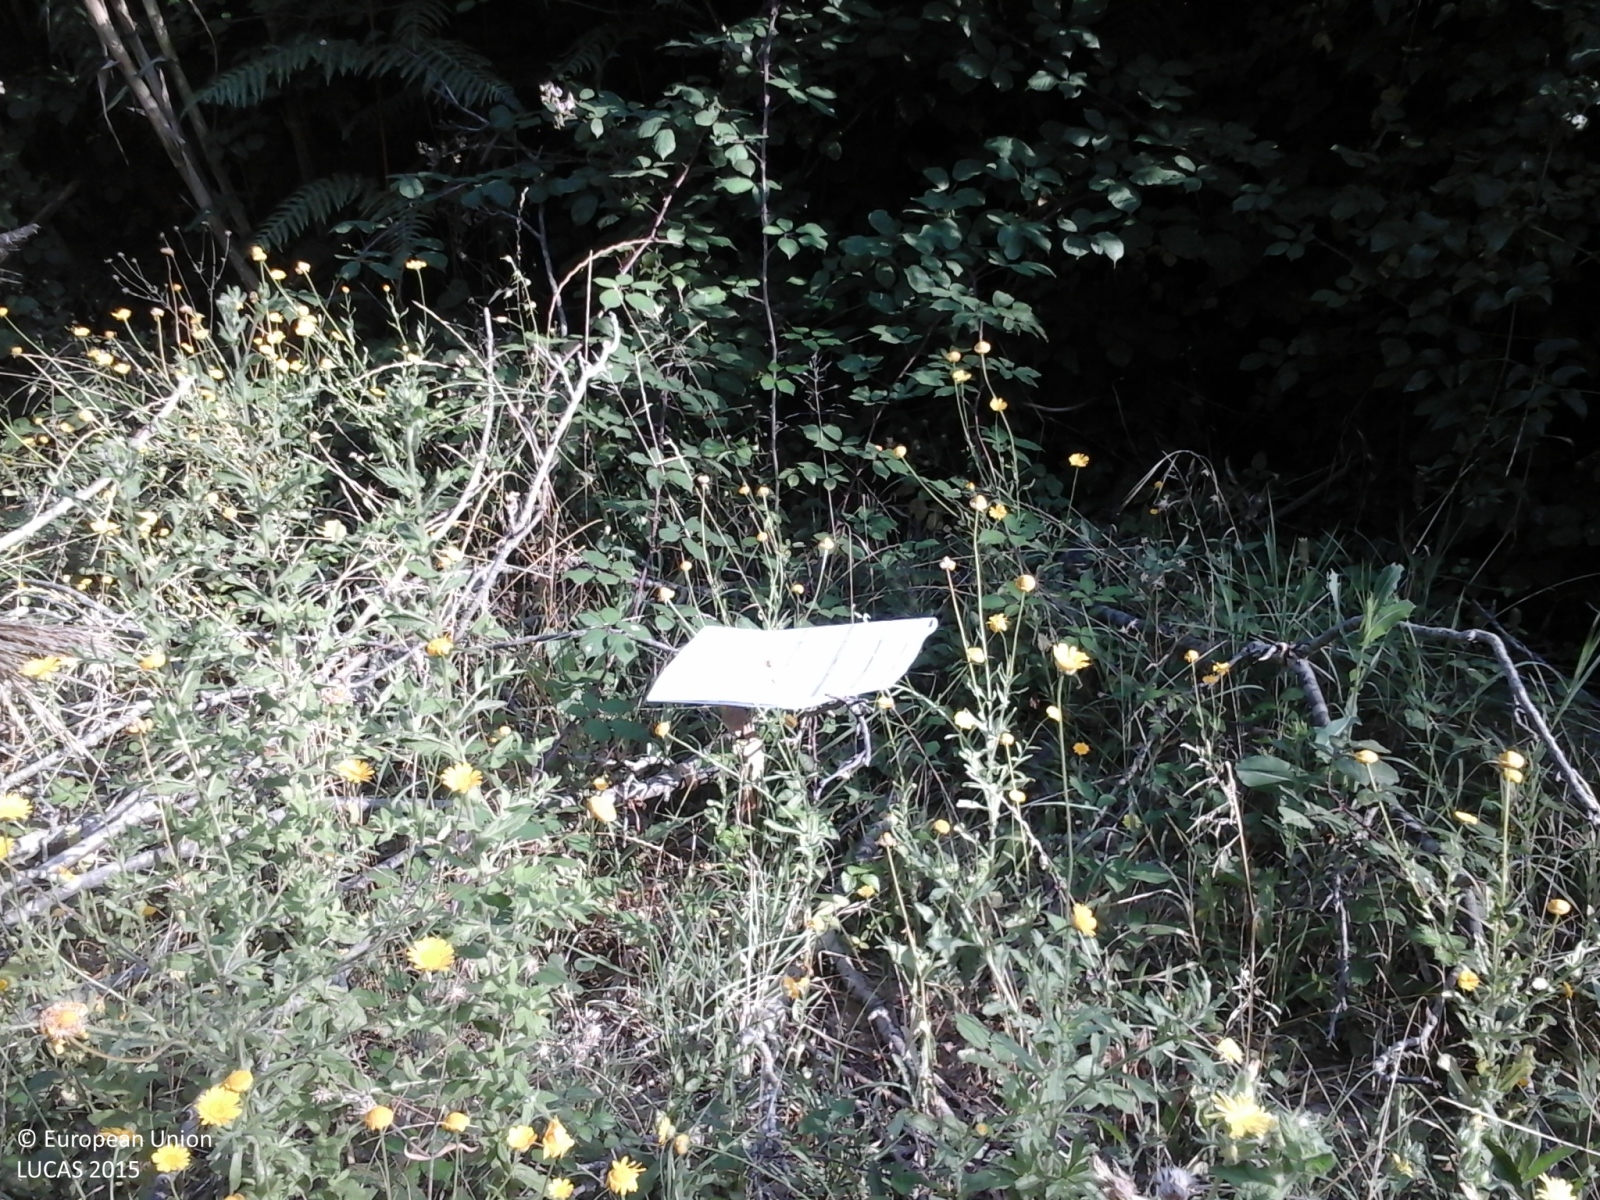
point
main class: Grassland
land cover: Grassland with sparse tree/shrub cover
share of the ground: > 75 %
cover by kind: herbaceous plants 85 %, shrubs 10 %, coniferous forest trees 5 %
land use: Agriculture (excluding fallow land and kitchen gardens)
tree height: > 5 m
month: July
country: IT
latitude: 43.3021
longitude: 10.6268
